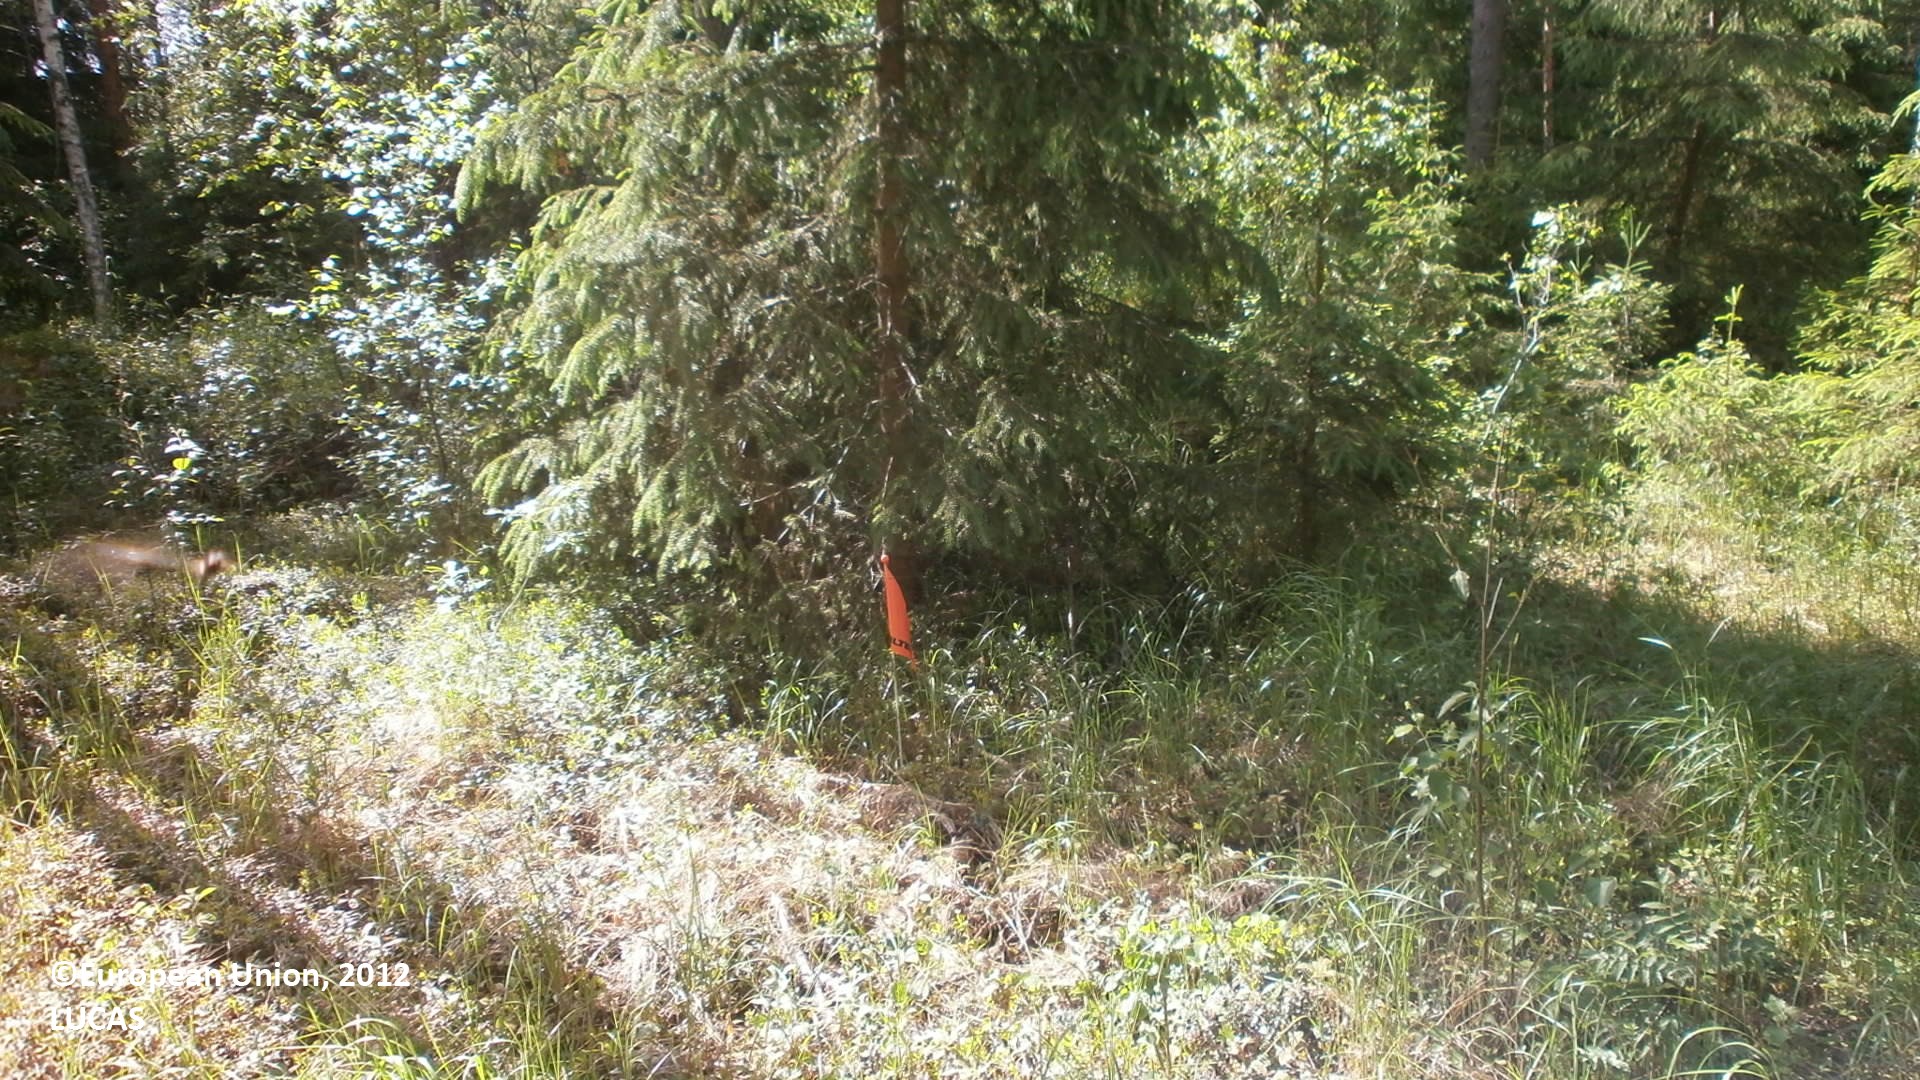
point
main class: Woodland
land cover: Pine dominated mixed woodland
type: boreal forest
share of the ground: 50 - 75 %
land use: Forestry
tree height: > 5 m
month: July
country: FI
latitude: 64.1189
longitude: 24.8435
